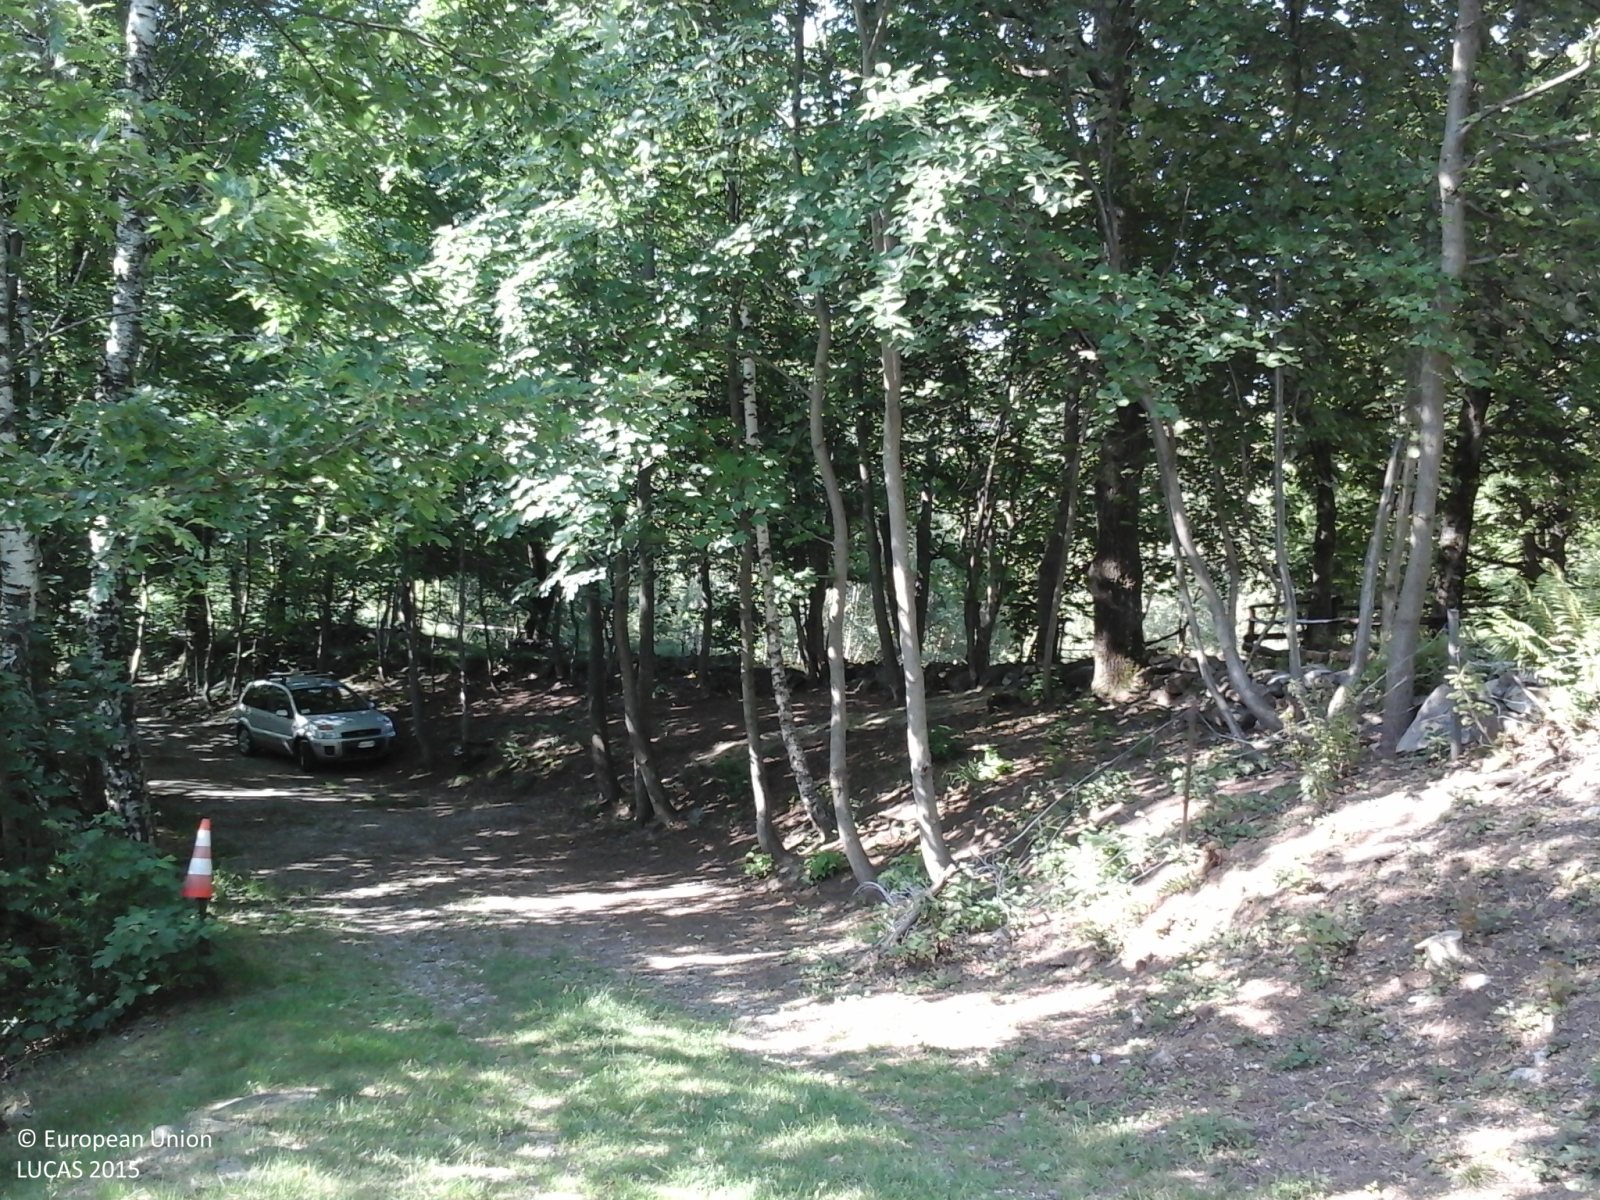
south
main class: Woodland
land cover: Broadleaved woodland
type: mesophytic deciduous forest
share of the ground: > 75 %
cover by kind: broadleaved forest trees 100 %
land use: Forestry
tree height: > 5 m
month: June
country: IT
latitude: 45.9799
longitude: 8.4662
